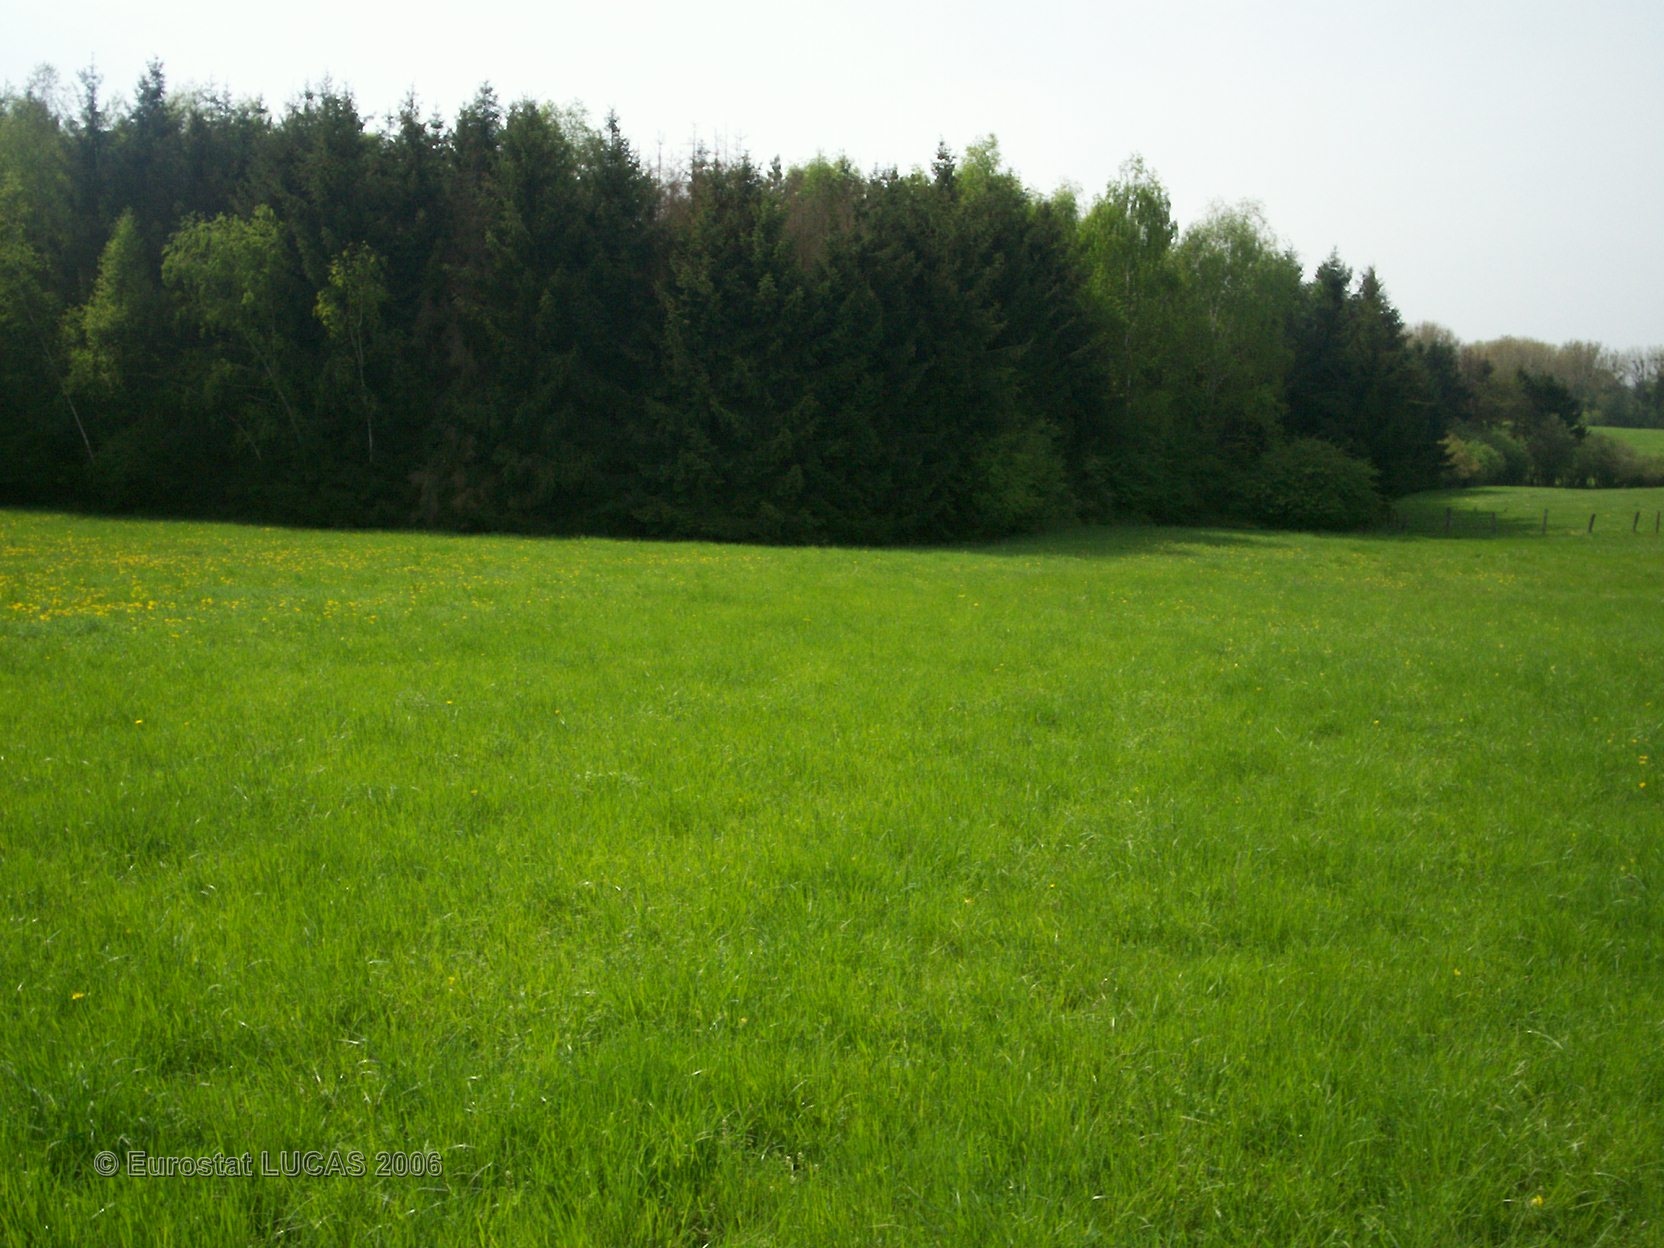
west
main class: Grassland
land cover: Grassland without tree/shrub cover
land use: Agriculture (excluding fallow land and kitchen gardens)
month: May
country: FR
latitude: 49.0665
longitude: 7.0577
